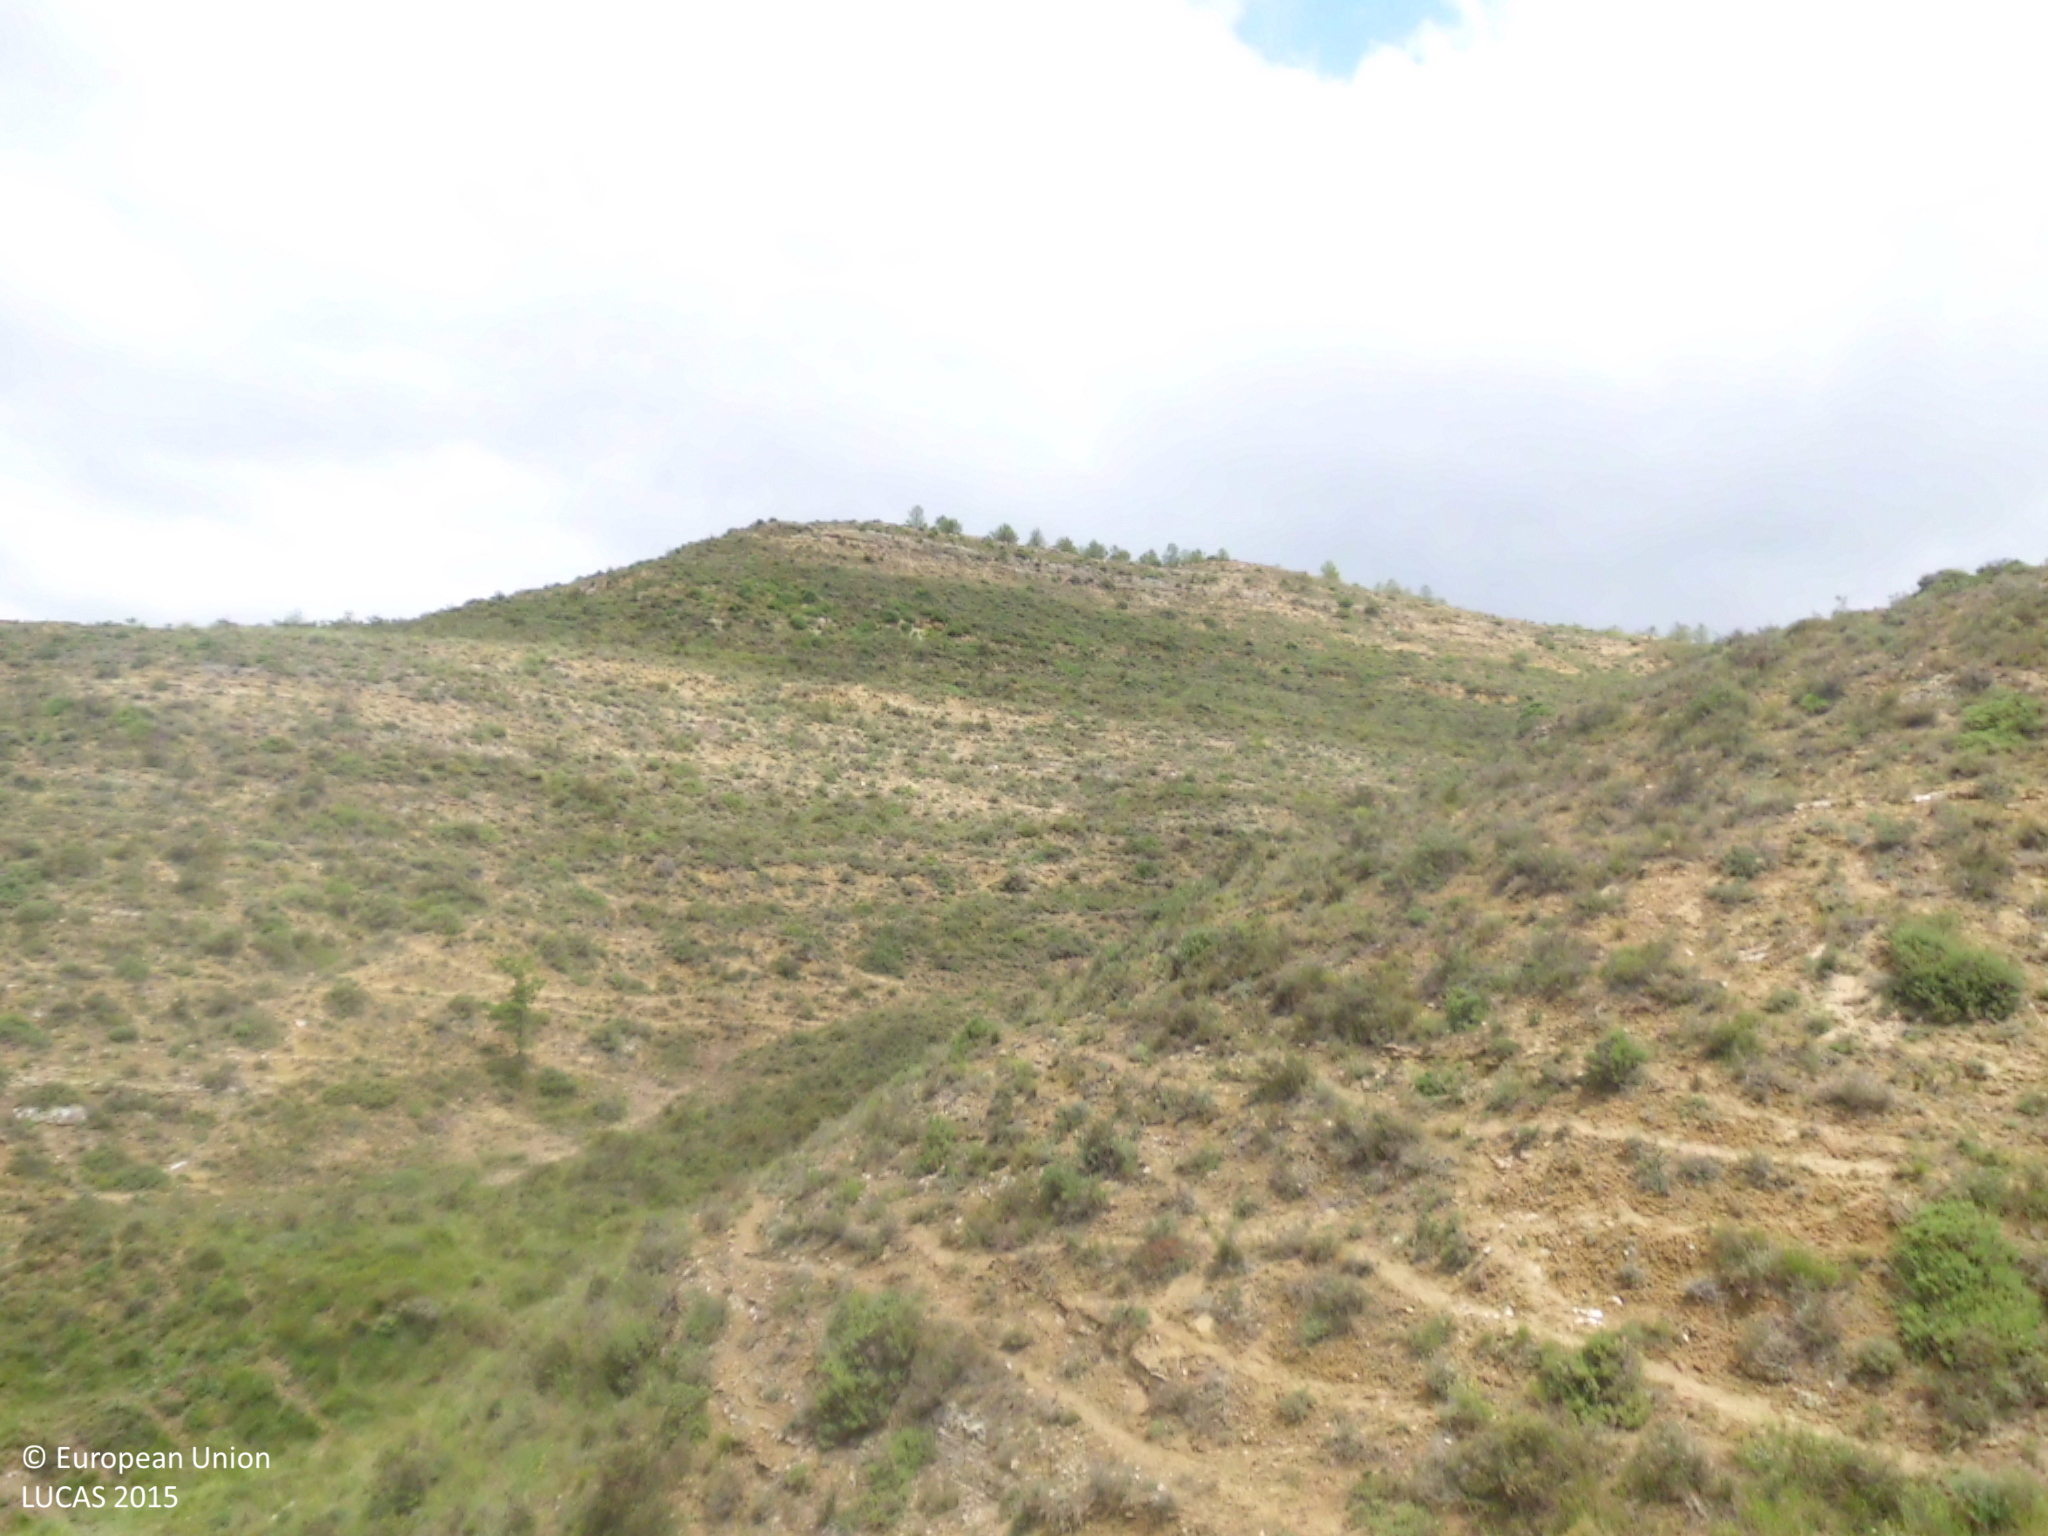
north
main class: Shrubland
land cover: Shrubland without tree cover
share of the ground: 50 - 75 %
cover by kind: shrubs 55 %, herbaceous plants 30 %, consolidated bare surface 15 %
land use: Semi-natural and natural areas not in use
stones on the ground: < 10 %
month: June
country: ES
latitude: 42.4752
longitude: -3.3764
